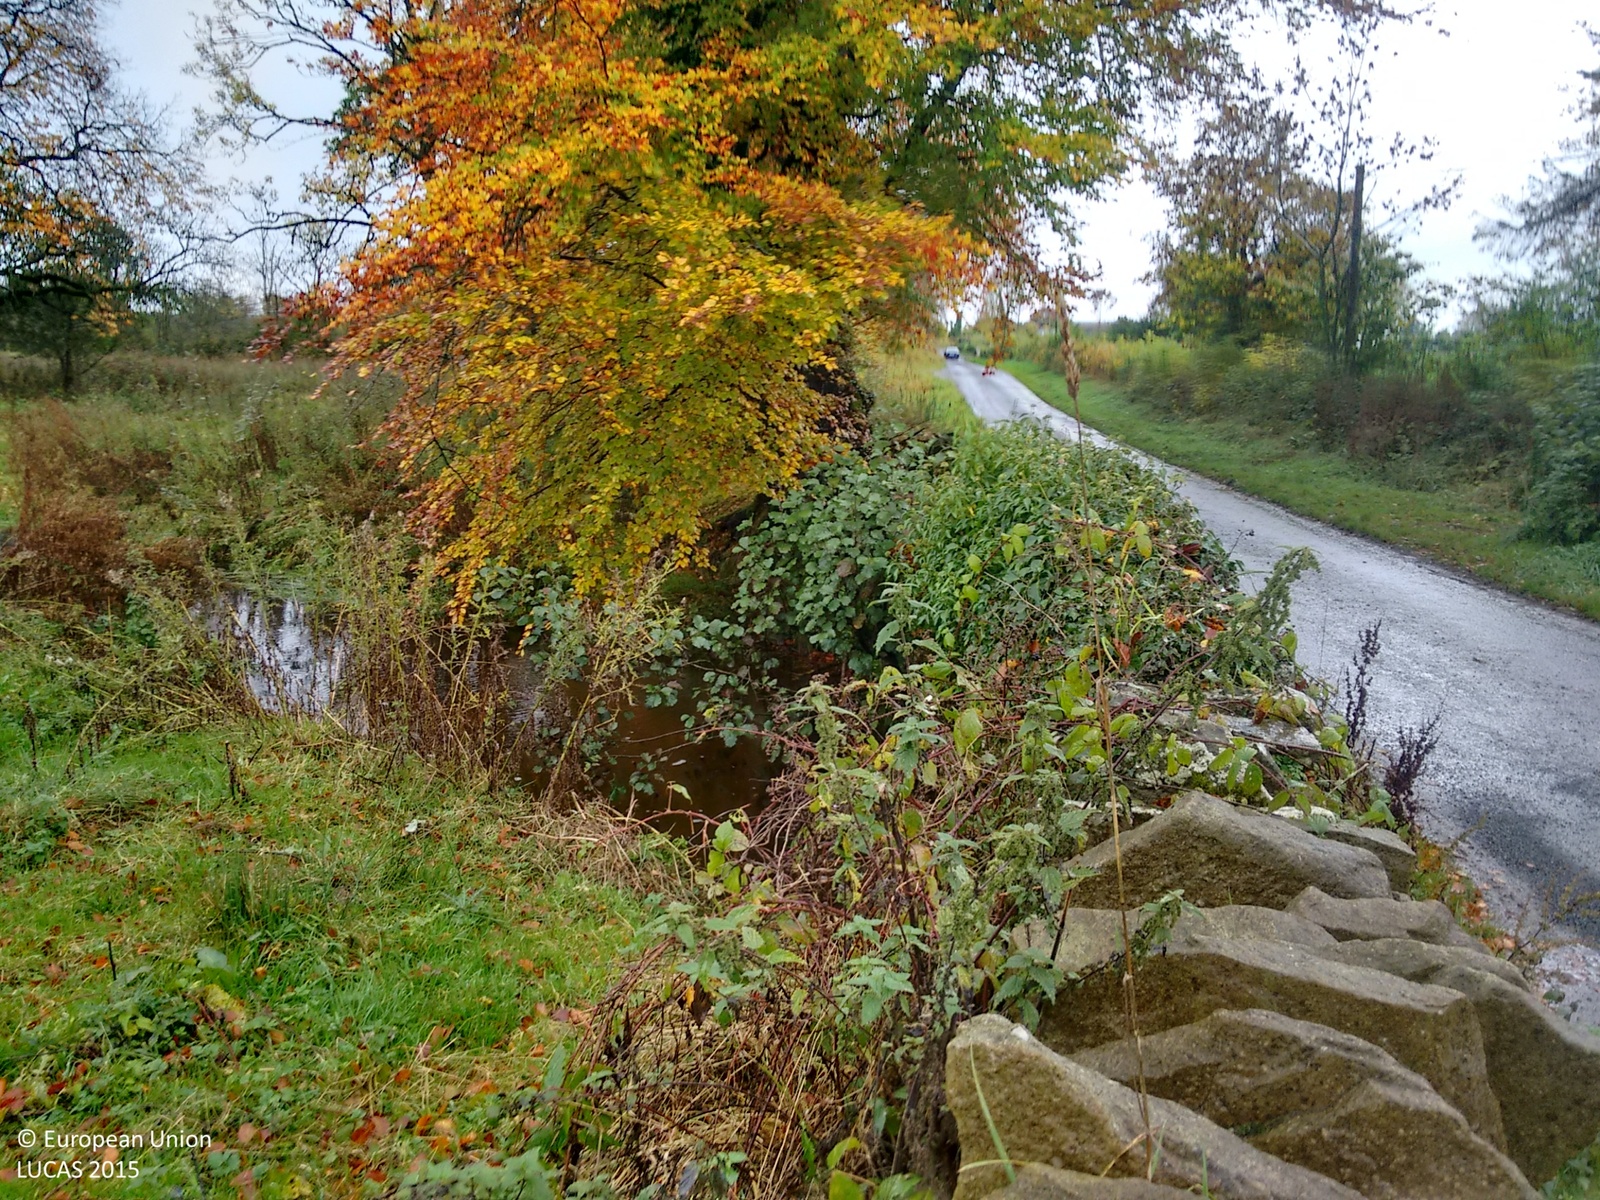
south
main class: Grassland
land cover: Grassland without tree/shrub cover
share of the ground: > 75 %
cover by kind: herbaceous plants 50 %, consolidated bare surface 15 %
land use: Agriculture (excluding fallow land and kitchen gardens)
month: October
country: IE
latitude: 52.9601
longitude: -7.6251
